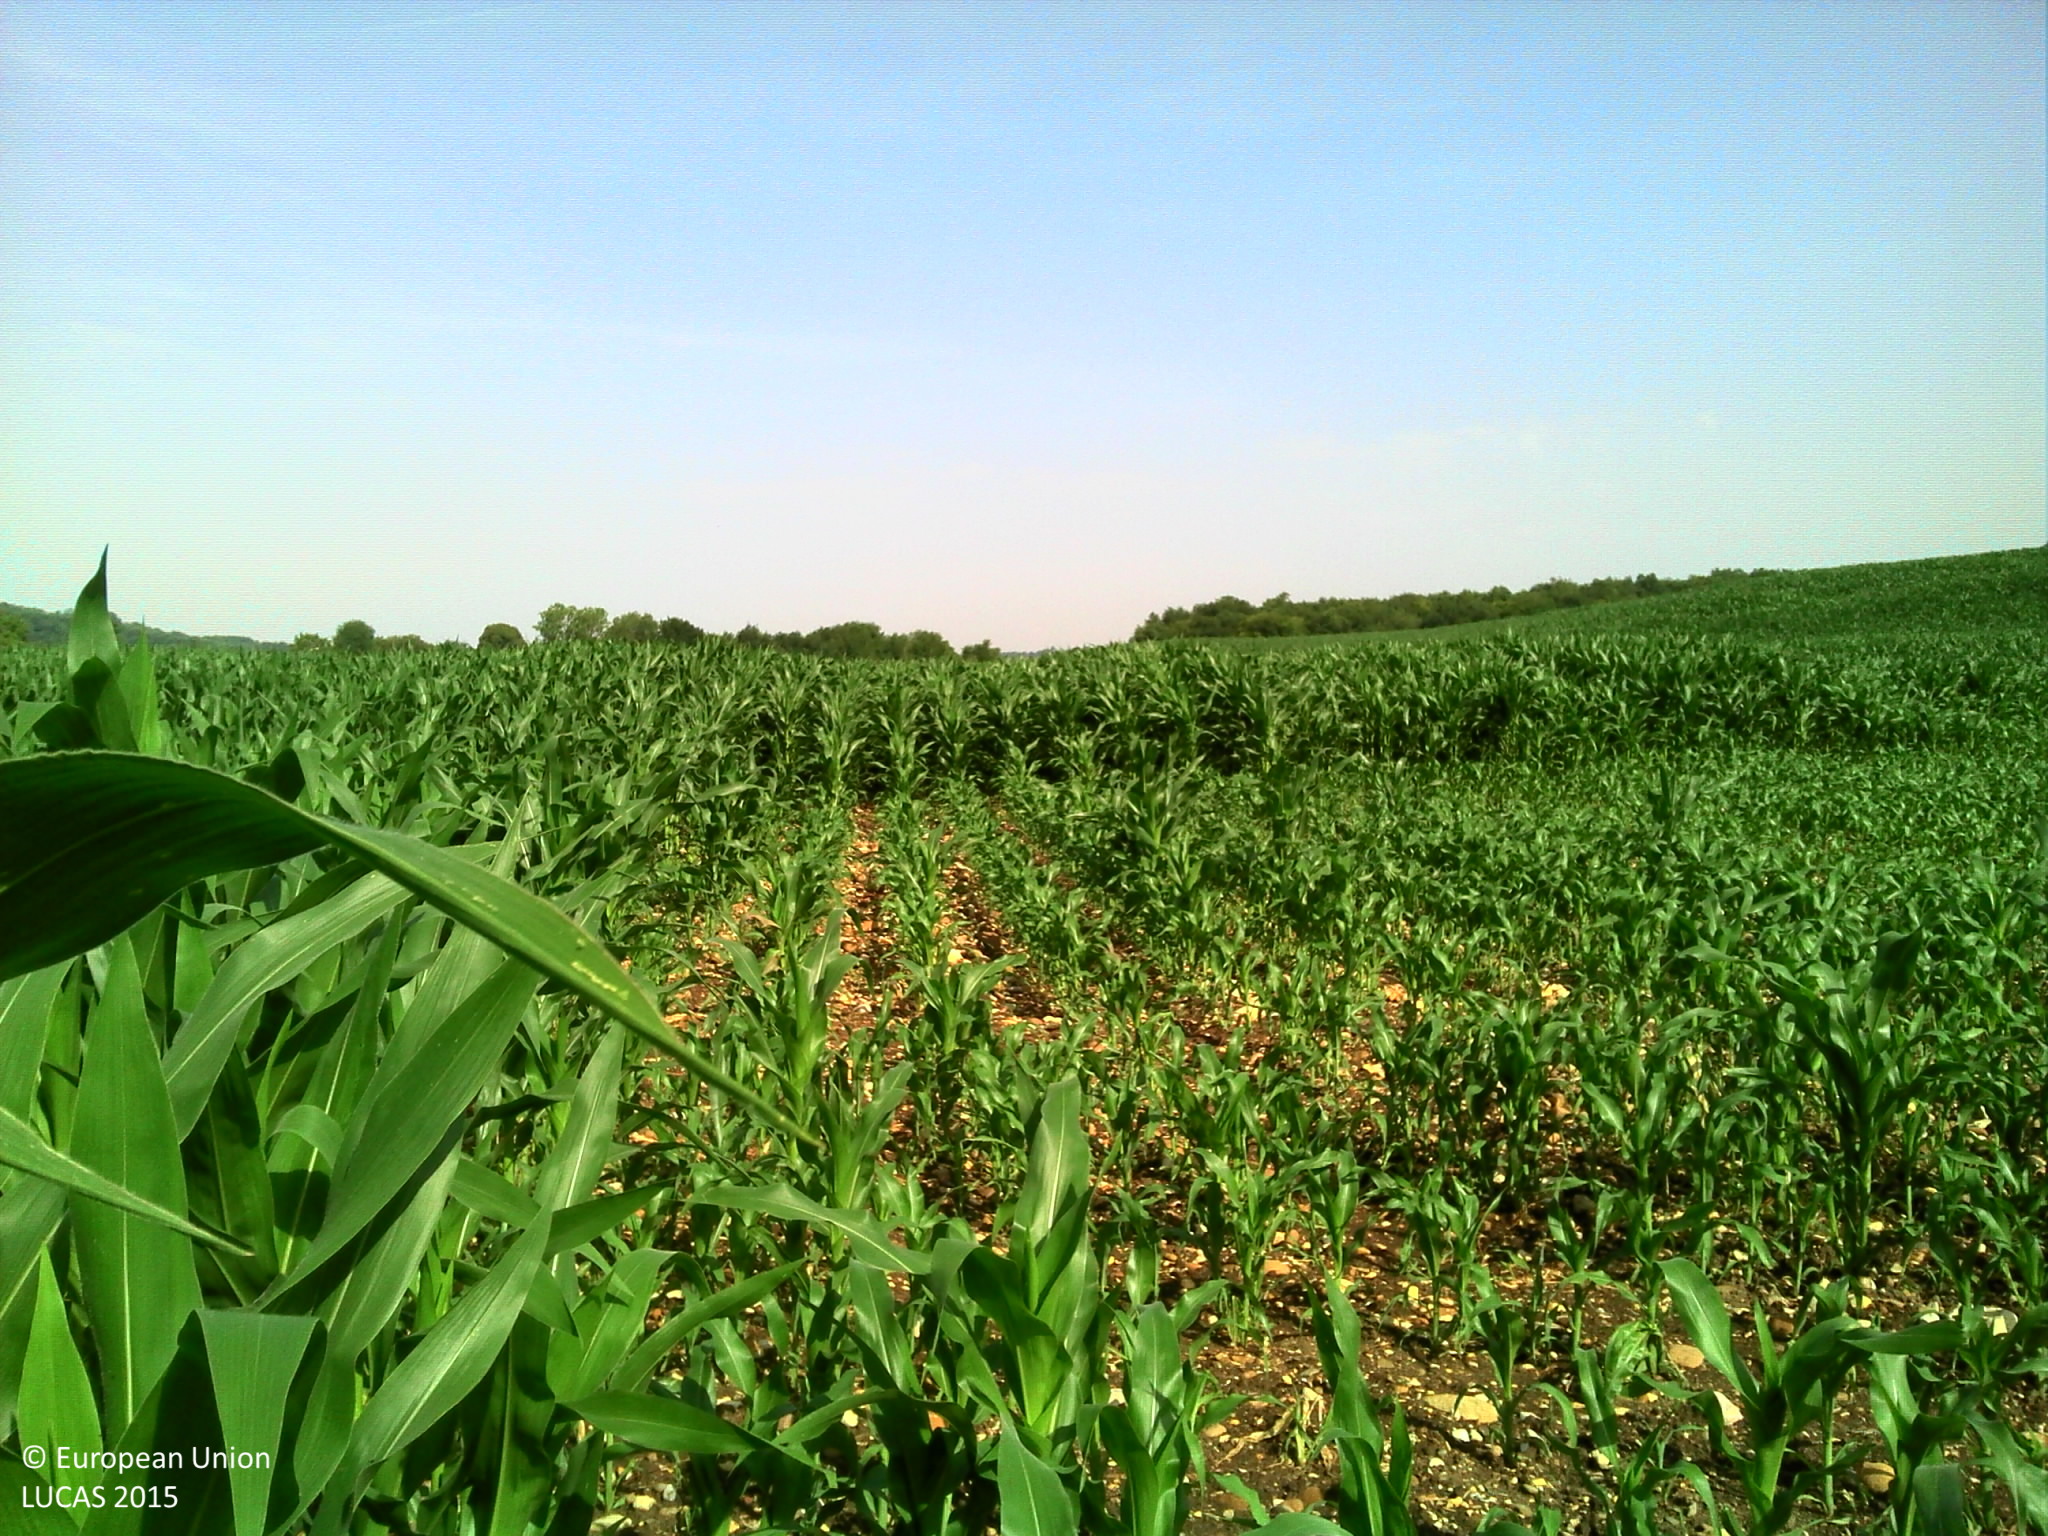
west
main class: Cropland
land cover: Maize
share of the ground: > 75 %
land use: Agriculture (excluding fallow land and kitchen gardens)
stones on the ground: 10 - 25 %
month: July
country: FR
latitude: 45.7646
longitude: 5.3880
